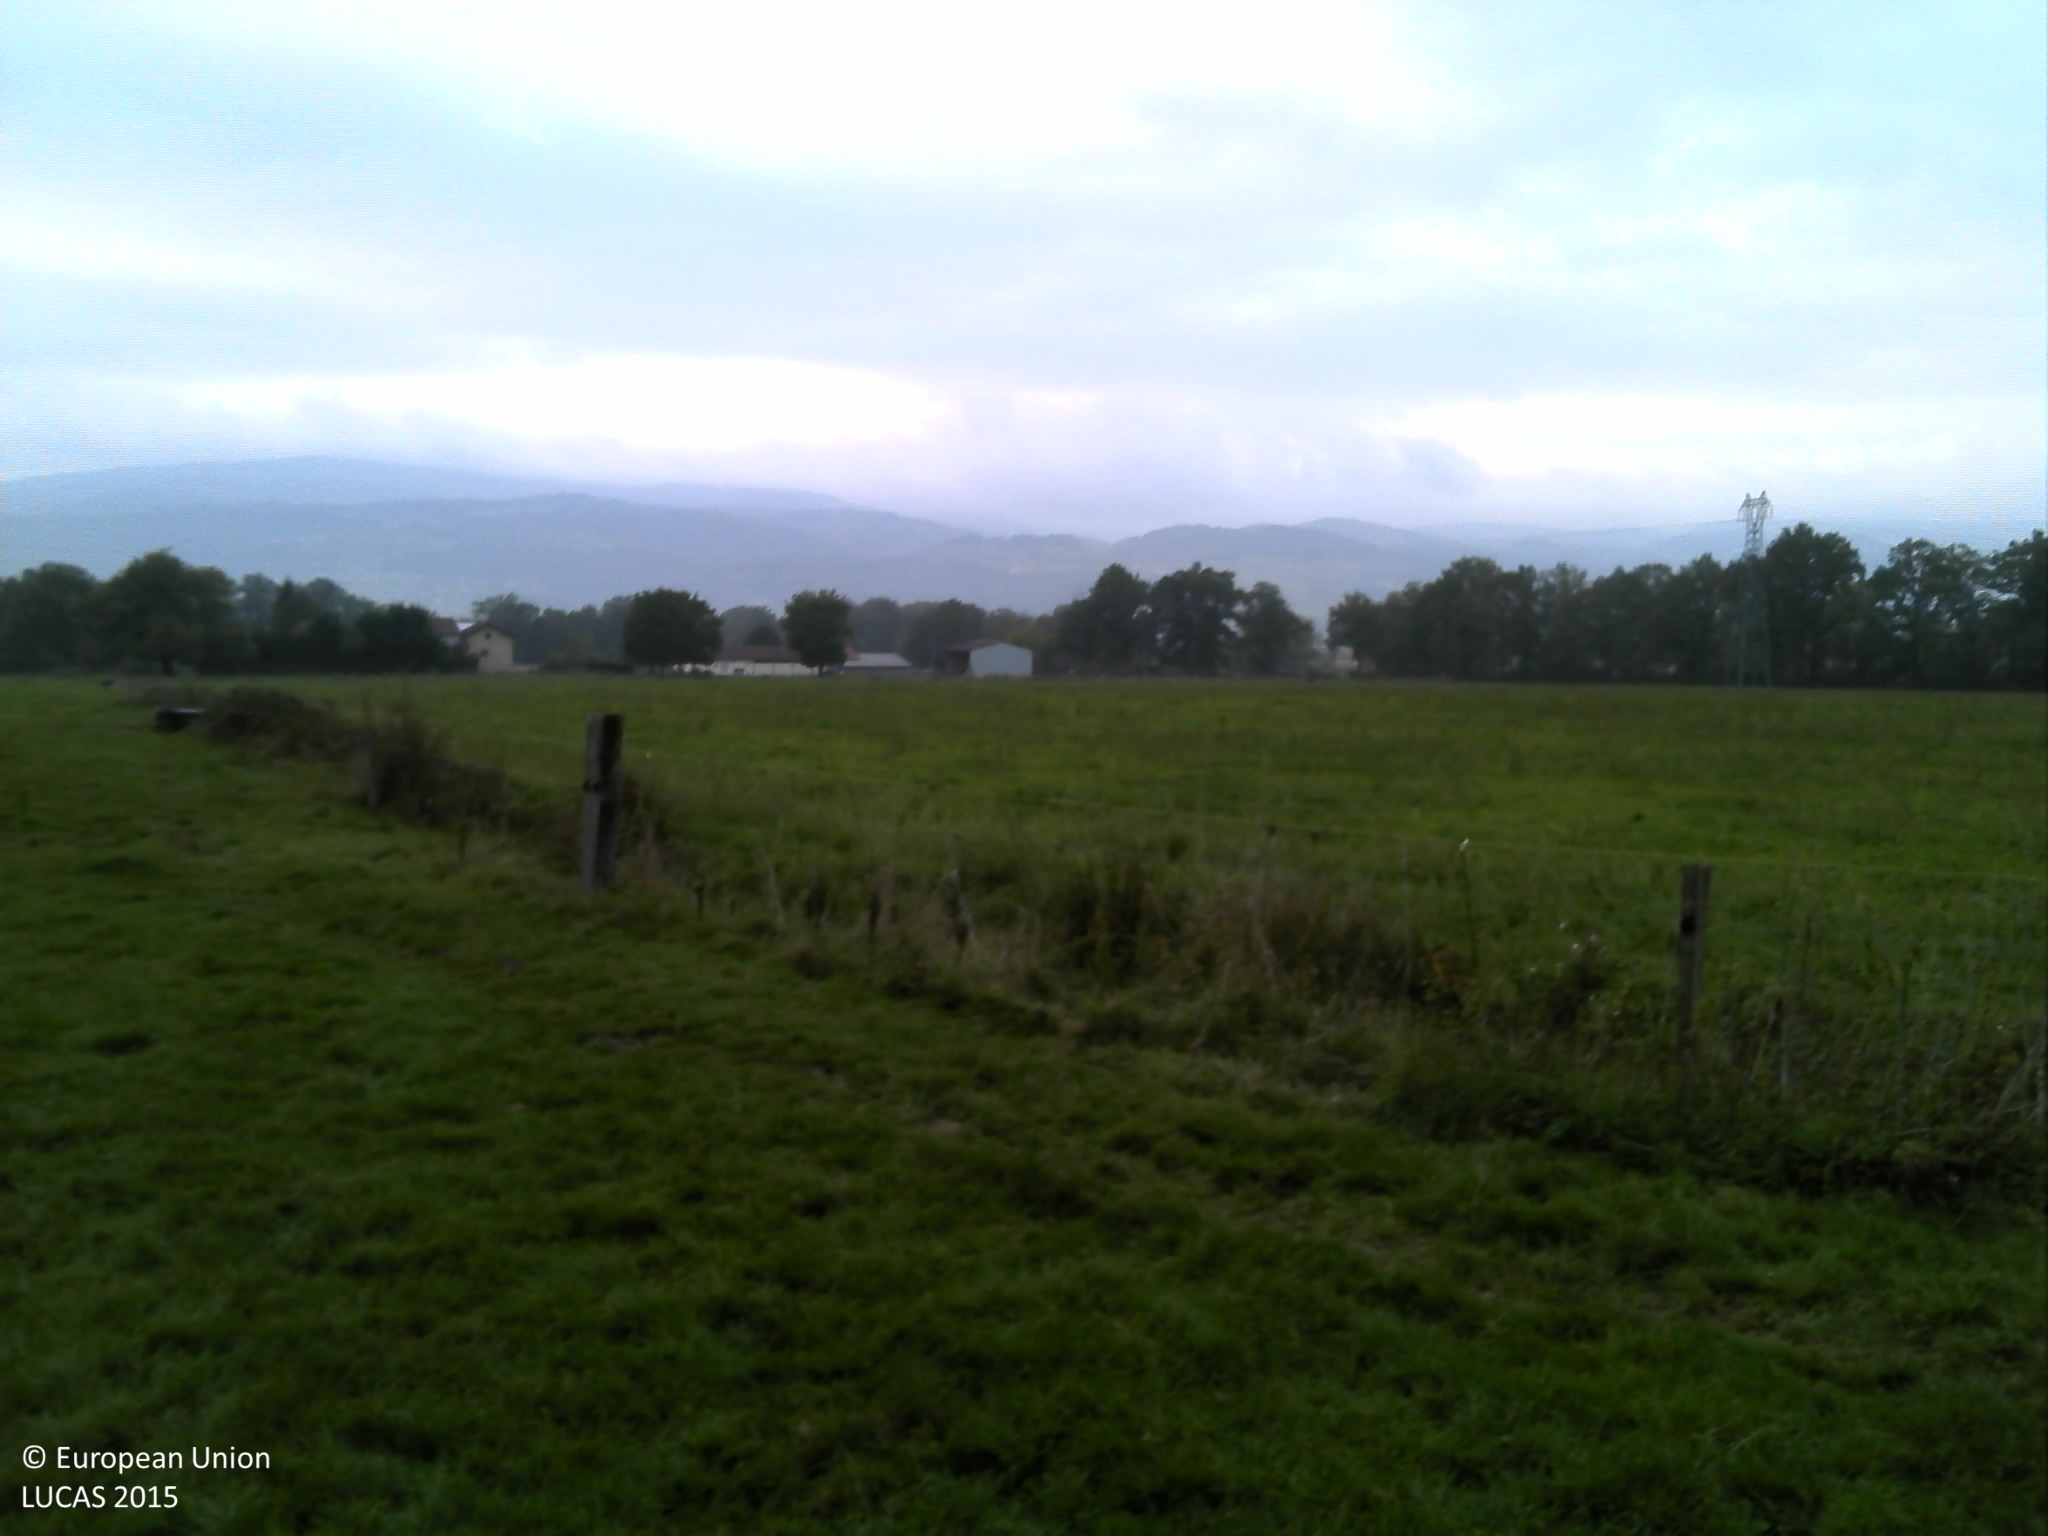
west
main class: Grassland
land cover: Grassland without tree/shrub cover
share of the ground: > 75 %
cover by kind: herbaceous plants 100 %
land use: Agriculture (excluding fallow land and kitchen gardens)
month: October
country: FR
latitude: 45.5370
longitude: 3.7658
